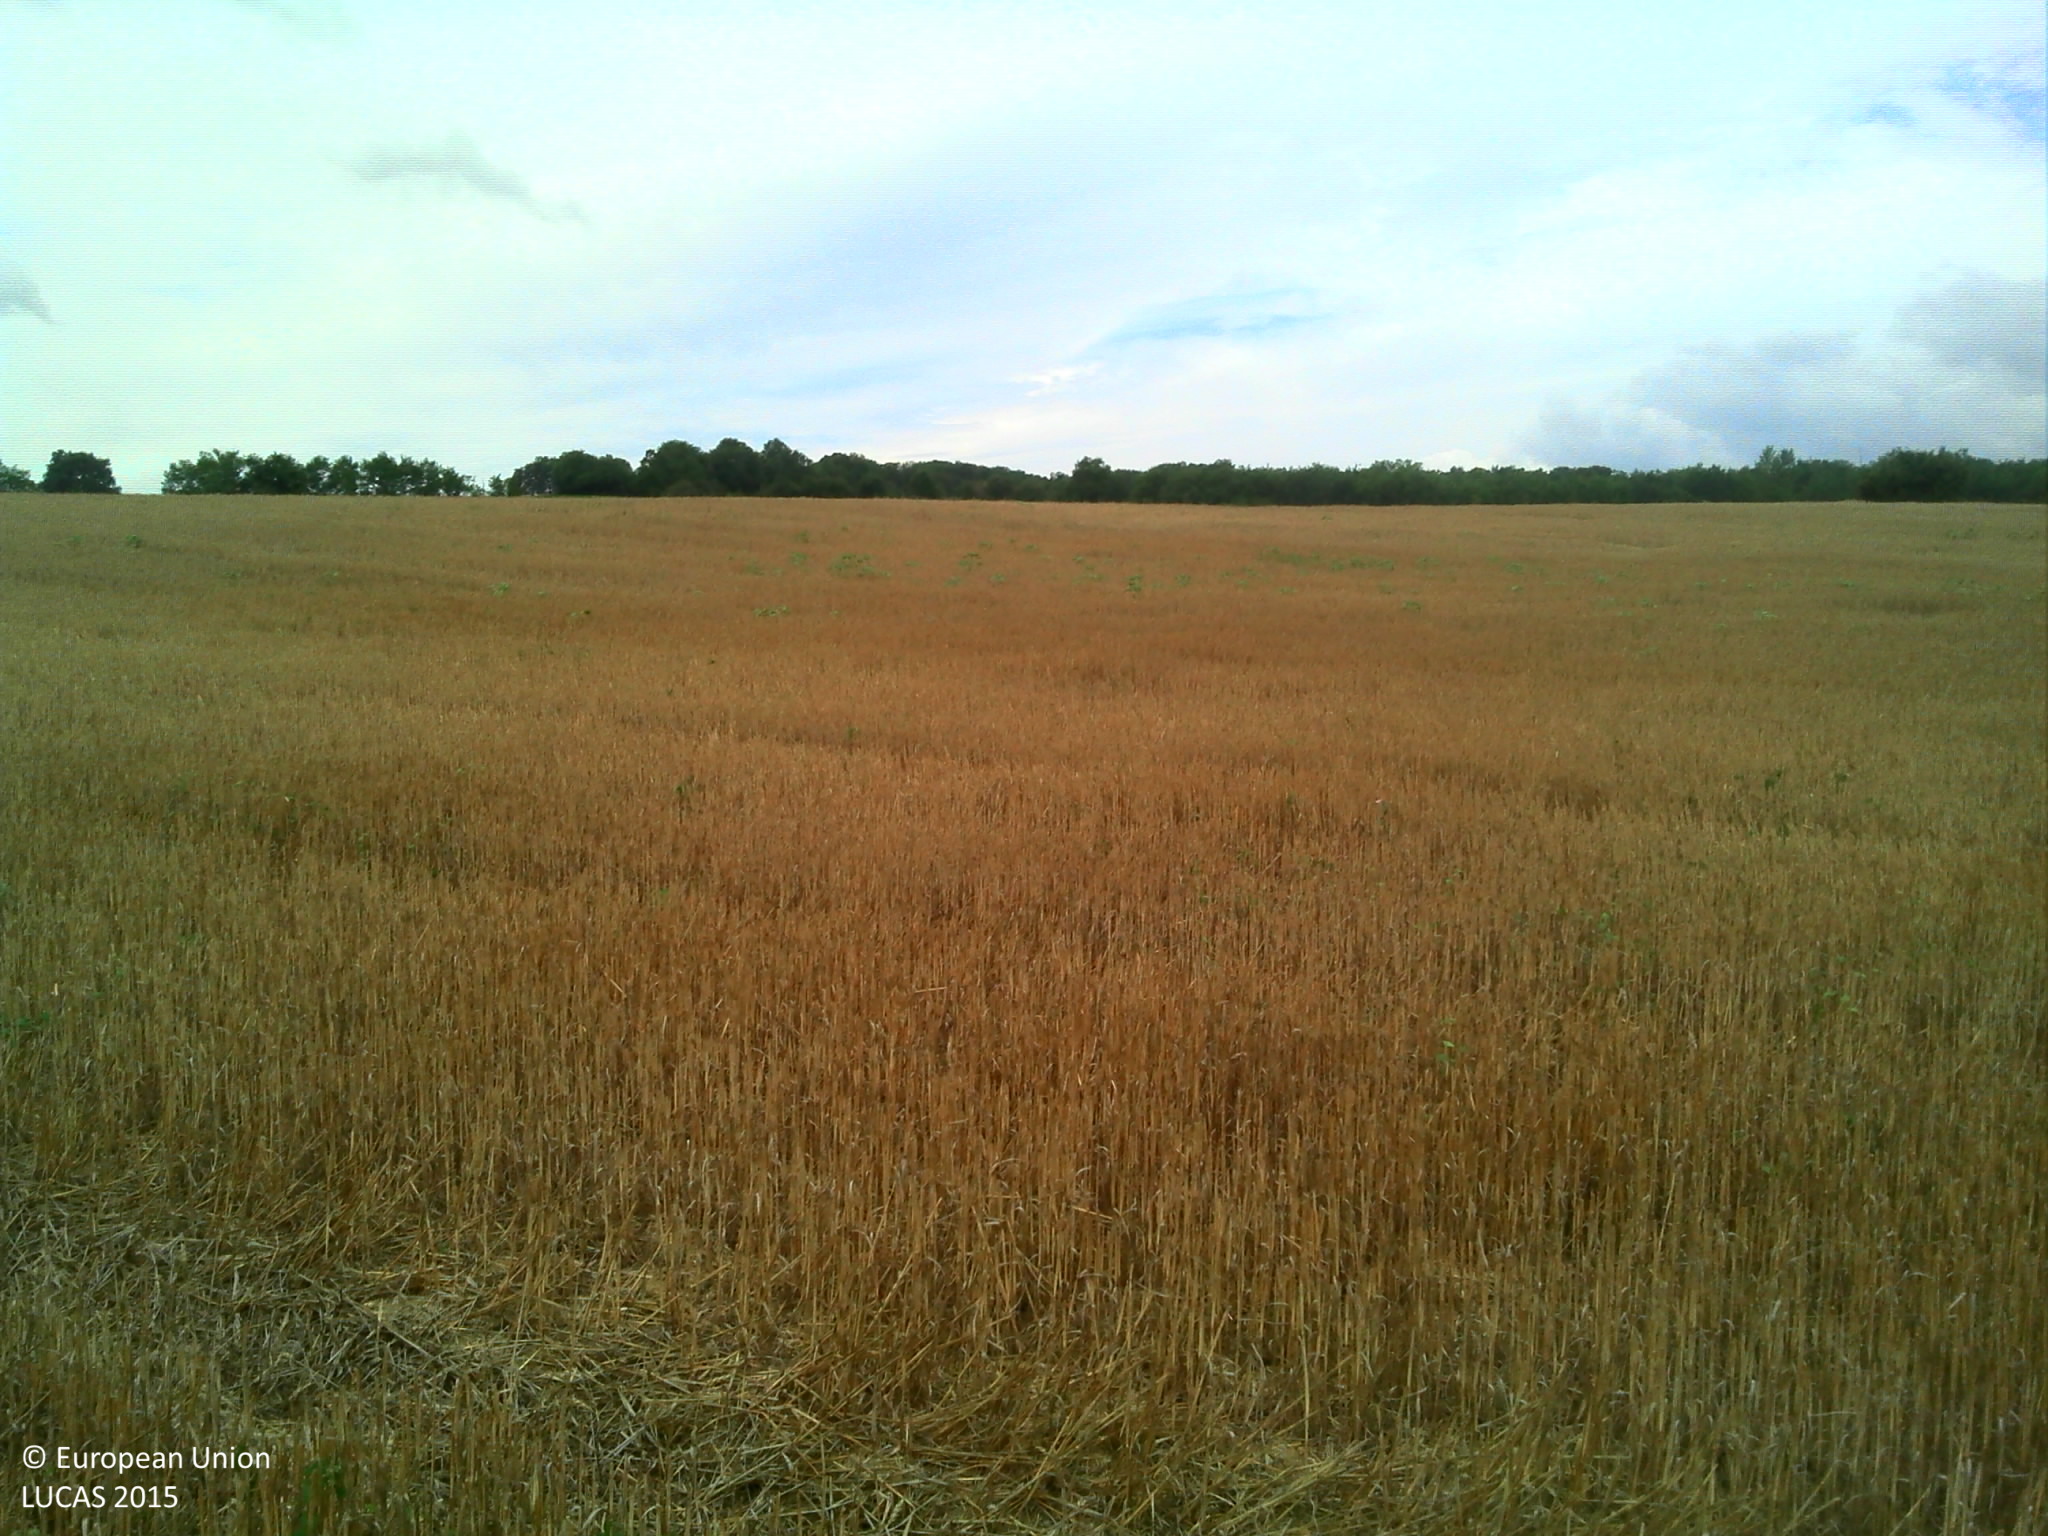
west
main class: Cropland
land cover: Common wheat
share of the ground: > 75 %
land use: Agriculture (excluding fallow land and kitchen gardens)
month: July
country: FR
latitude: 44.0767
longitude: 0.6931
